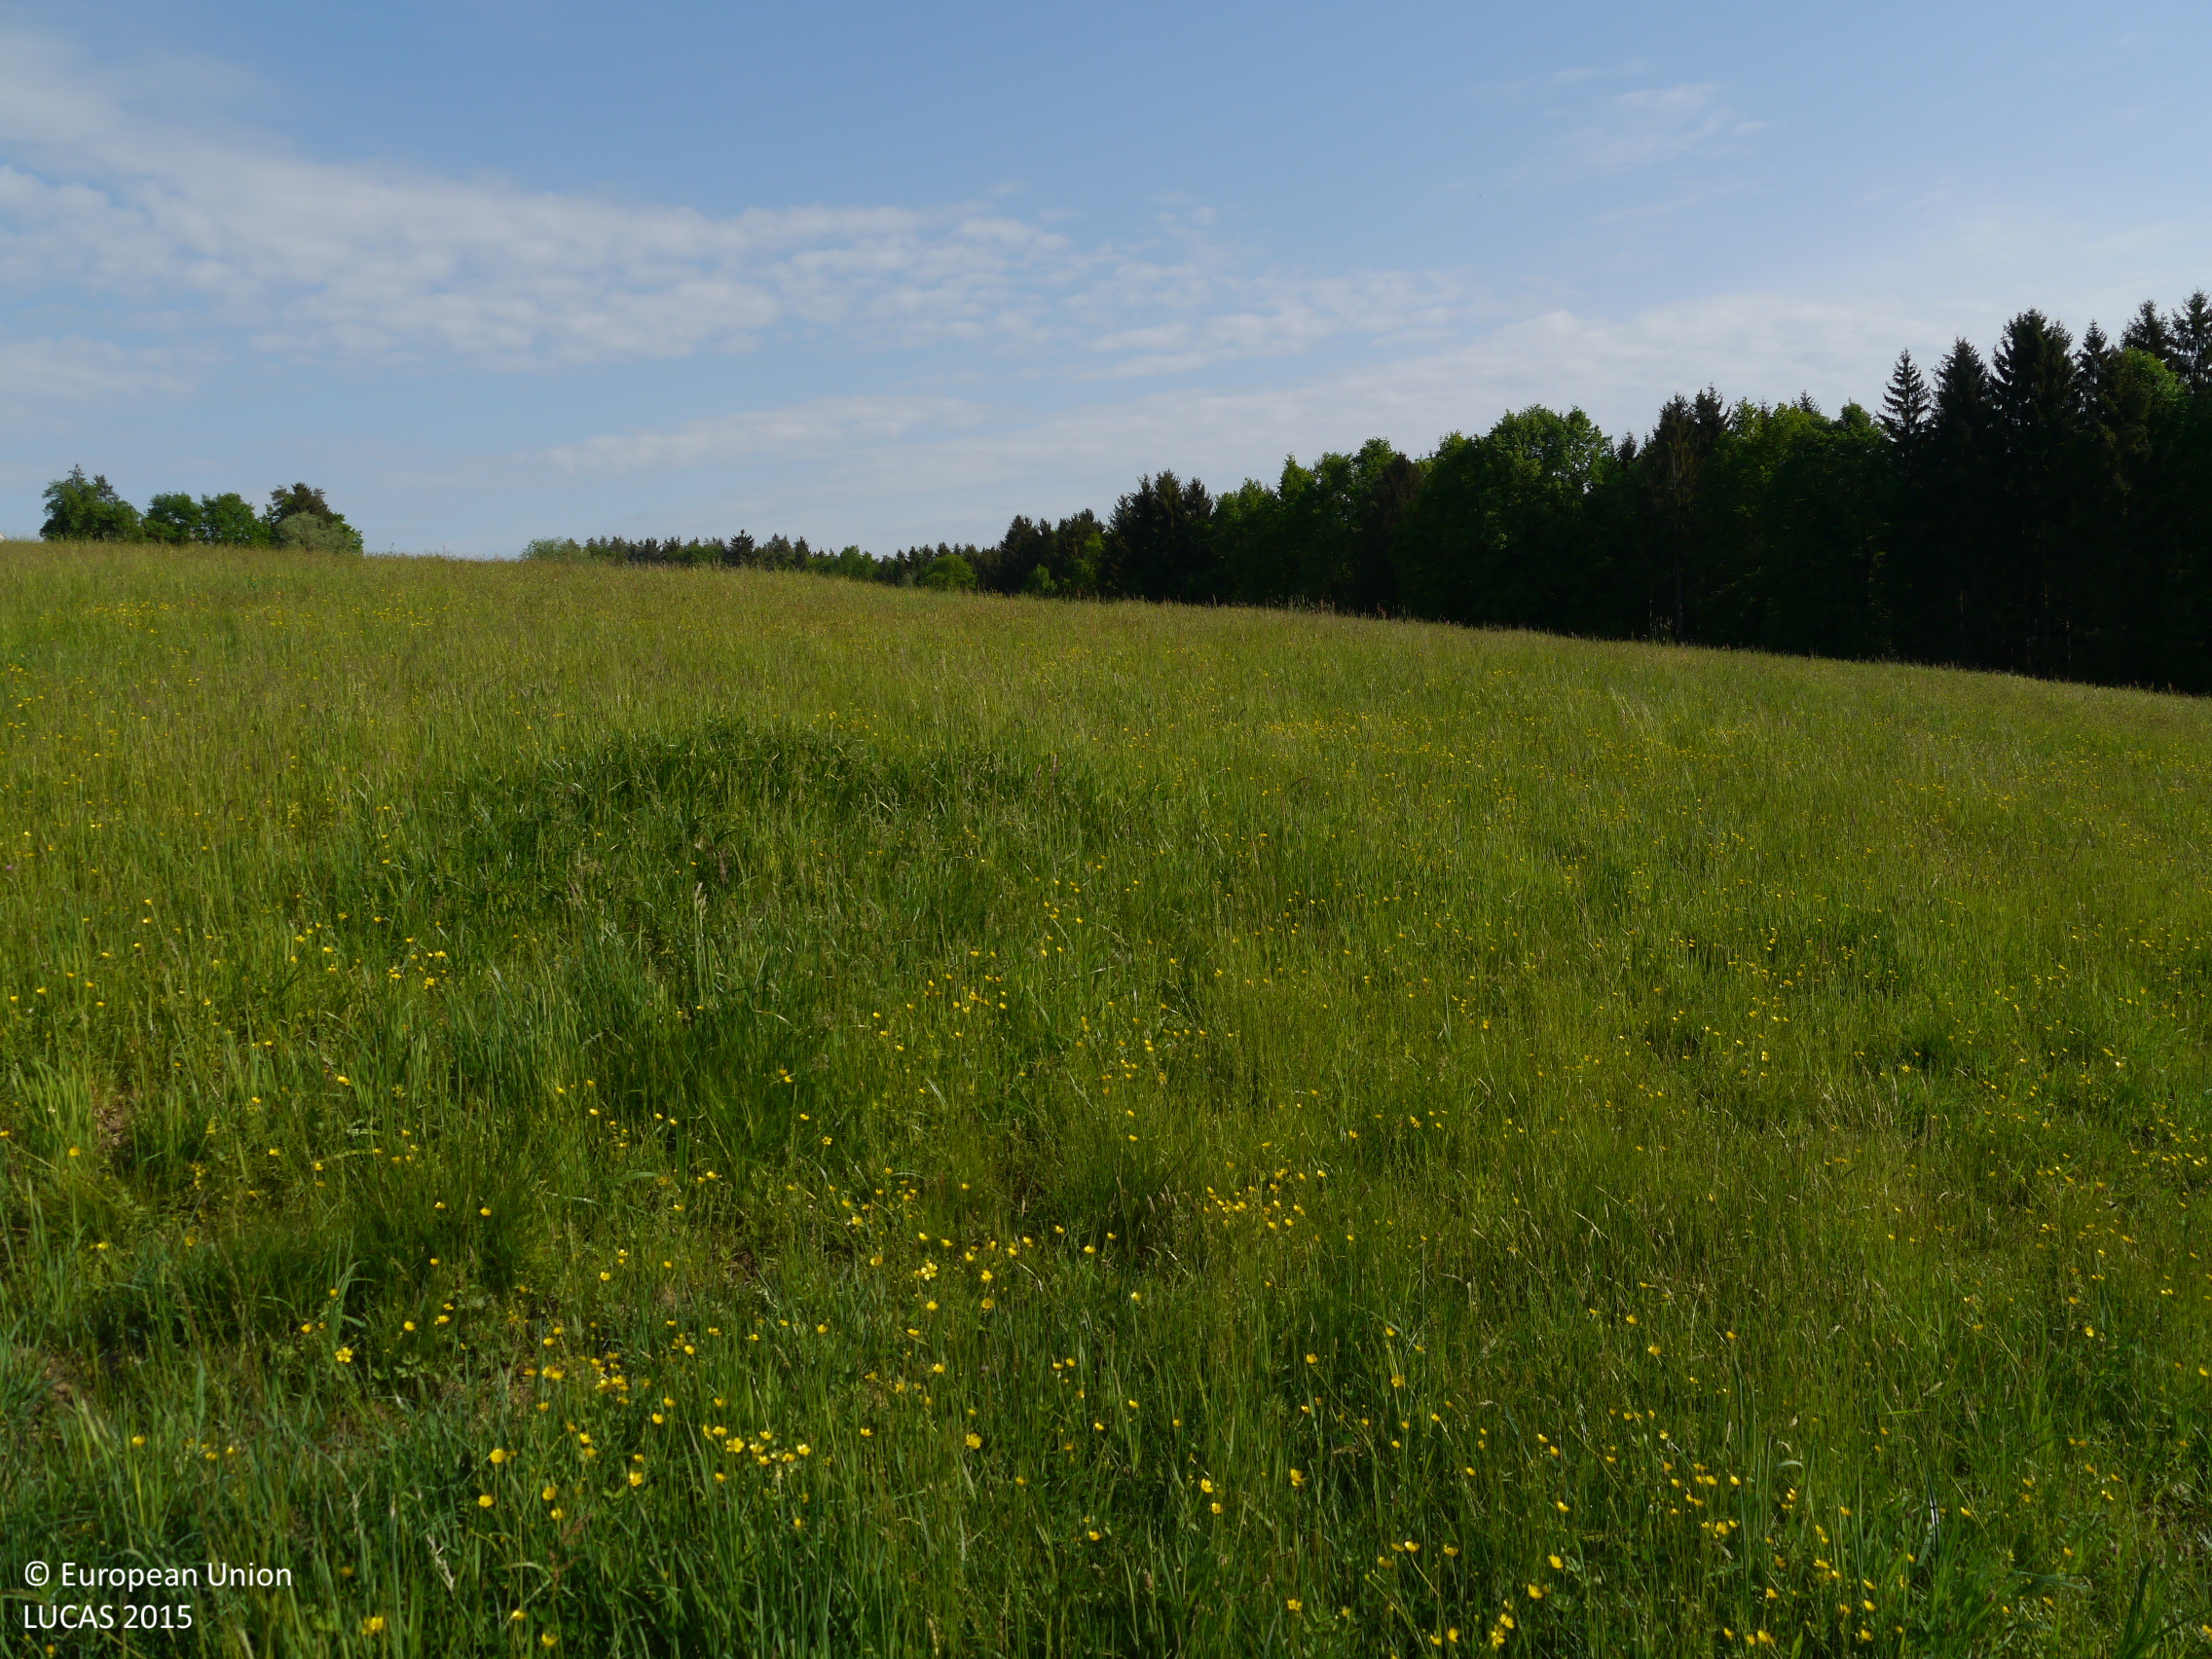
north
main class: Grassland
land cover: Grassland without tree/shrub cover
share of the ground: > 75 %
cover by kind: herbaceous plants 100 %
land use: Agriculture (excluding fallow land and kitchen gardens)
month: May
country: AT
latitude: 47.0331
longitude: 15.2763
